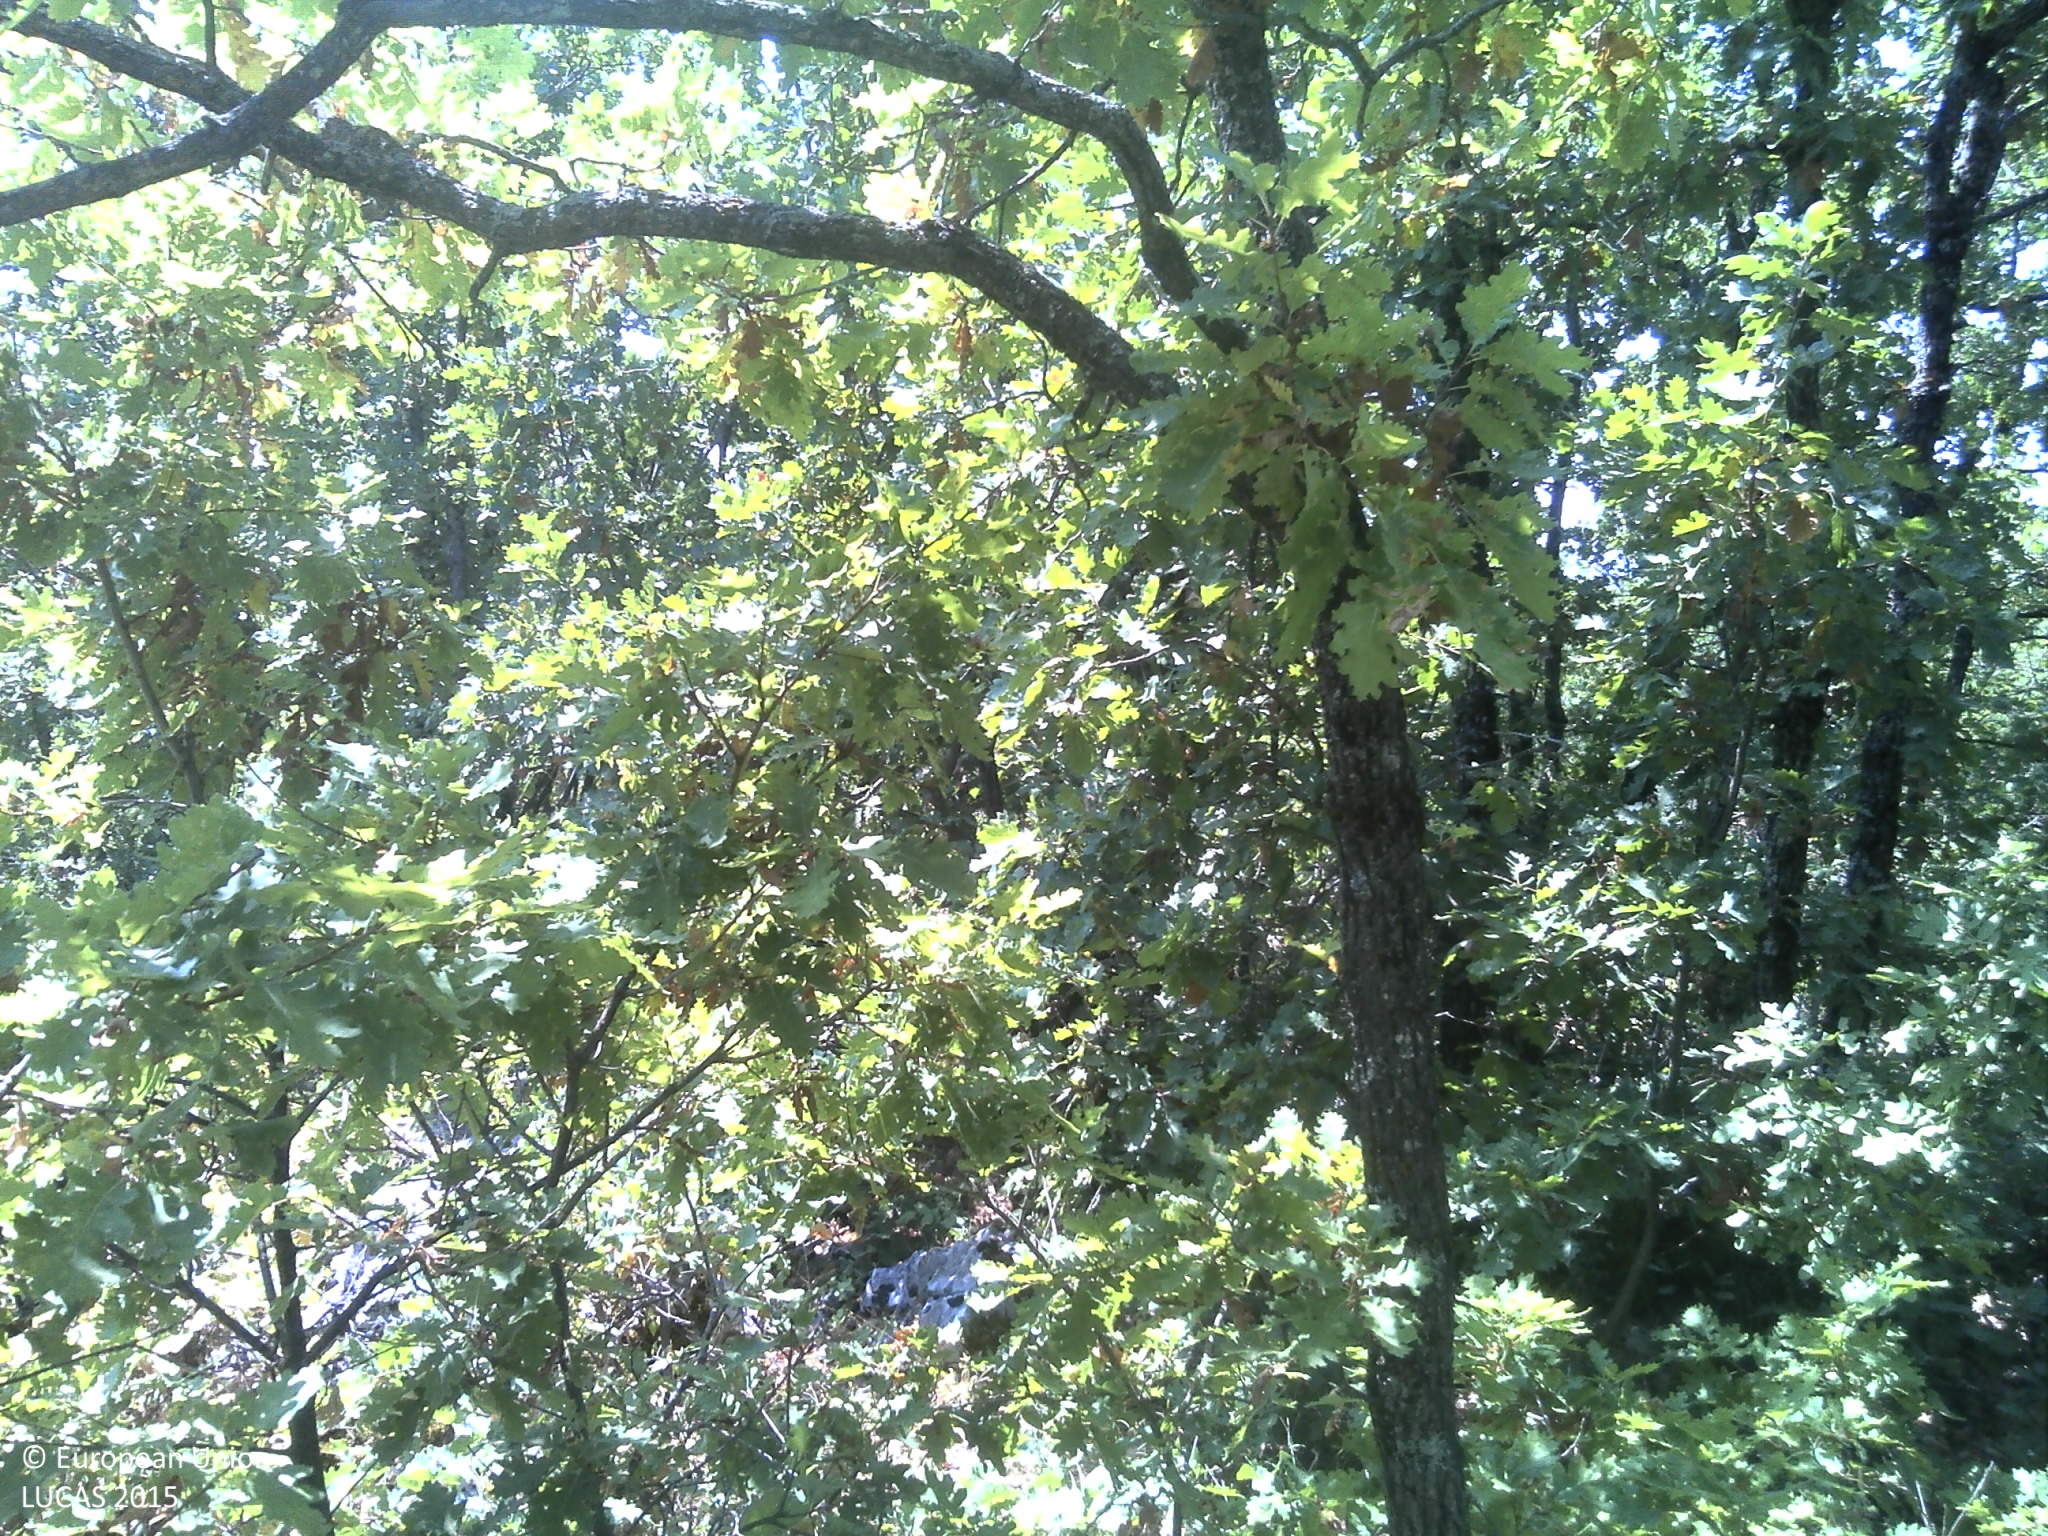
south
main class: Woodland
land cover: Broadleaved woodland
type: thermophilous deciduous forest
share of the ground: > 75 %
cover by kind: broadleaved forest trees 70 %, shrubs 10 %, herbaceous plants 5 %, lichens and mosses 5 %, consolidated bare surface 5 %, unconsolidated bare surface 5 %
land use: Semi-natural and natural areas not in use
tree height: > 5 m
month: July
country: HR
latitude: 43.4632
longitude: 17.2474
